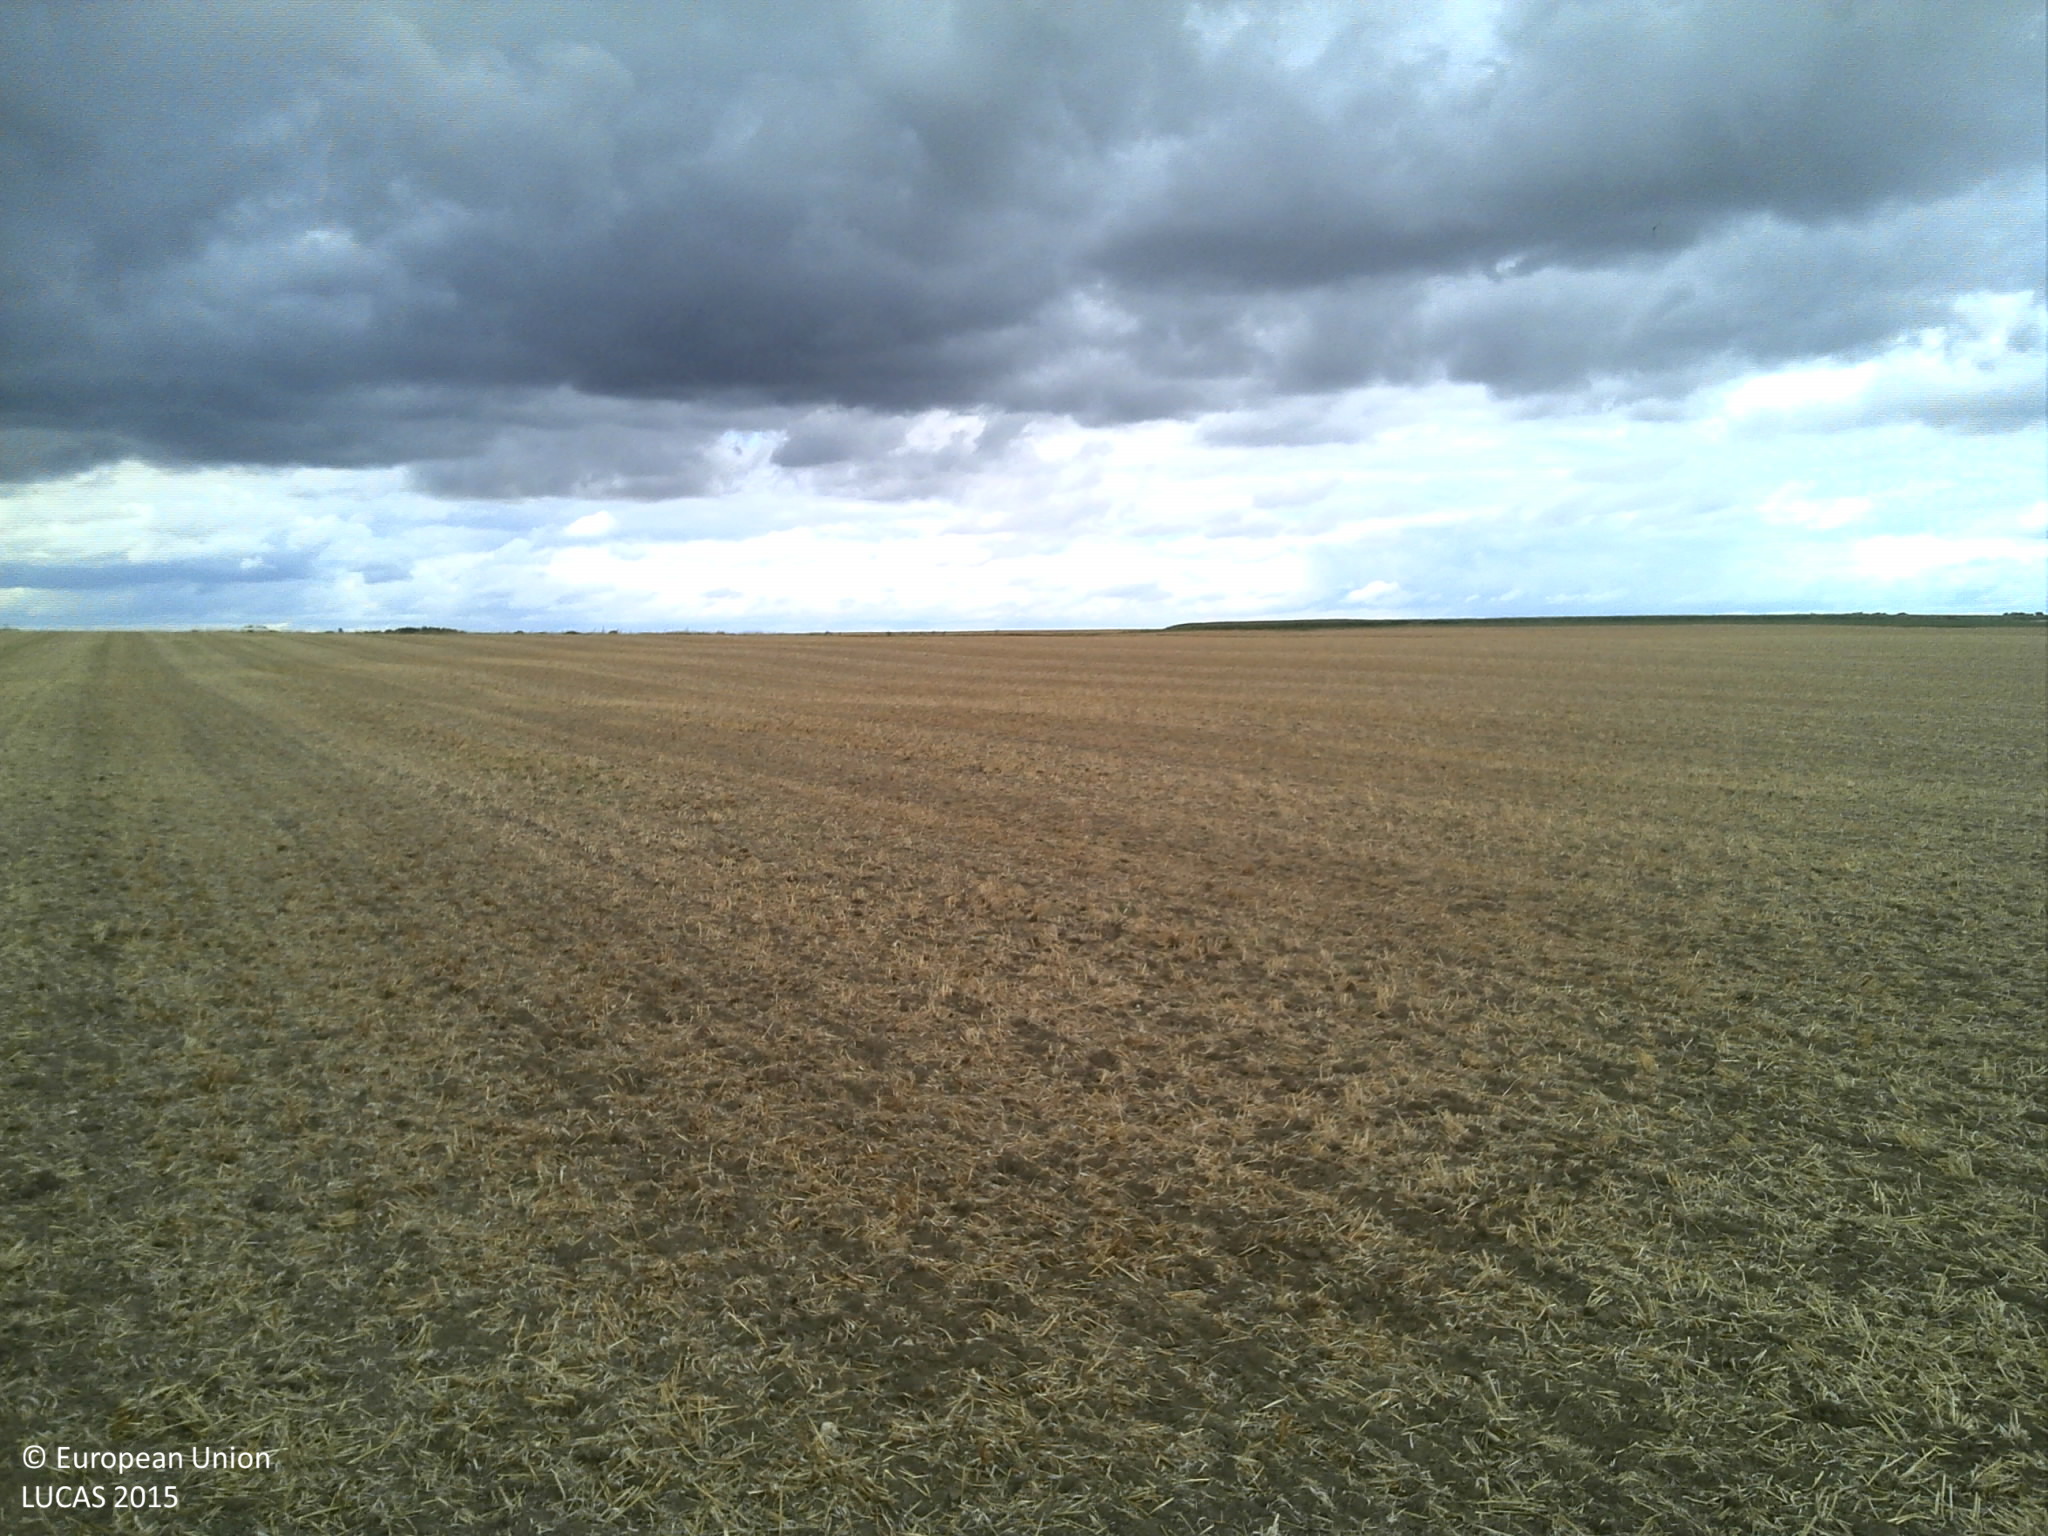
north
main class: Cropland
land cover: Barley
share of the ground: 25 - 50 %
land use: Agriculture (excluding fallow land and kitchen gardens)
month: July
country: FR
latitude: 49.4616
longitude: 4.6019
